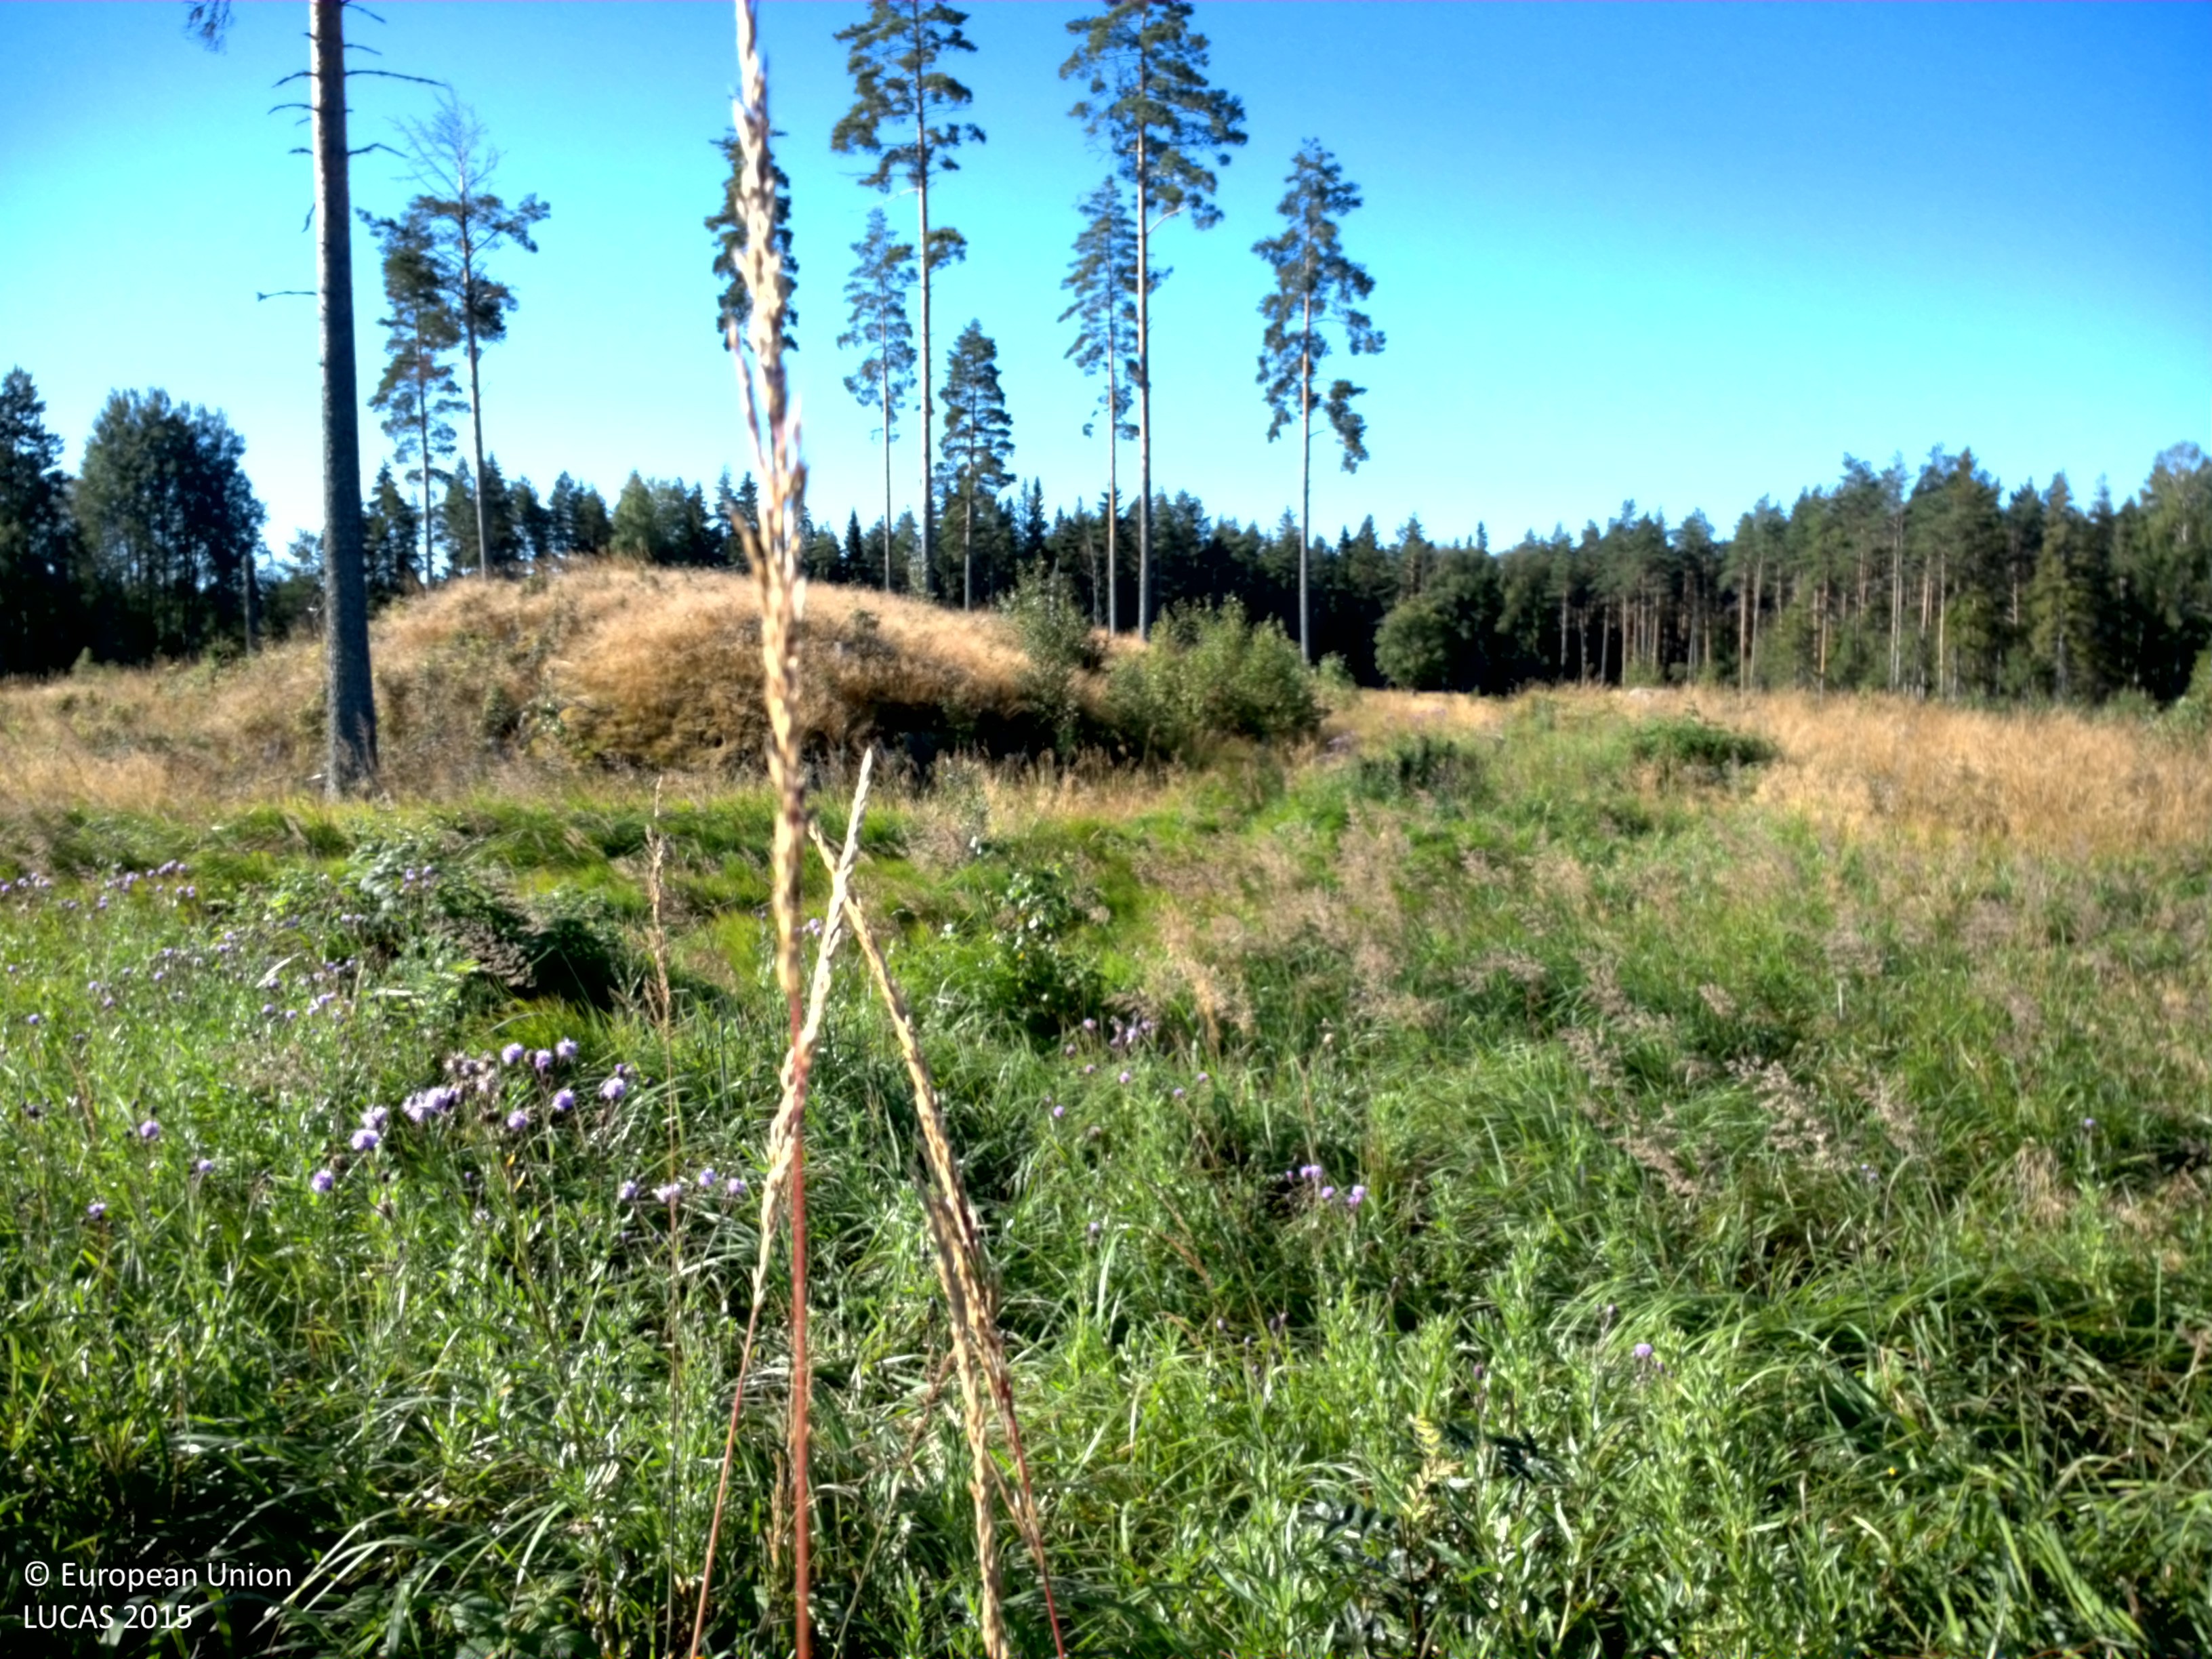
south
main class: Grassland
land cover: Grassland without tree/shrub cover
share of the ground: > 75 %
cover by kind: herbaceous plants 100 %
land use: Forestry
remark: Clear cut
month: August
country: SE
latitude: 60.1104
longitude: 17.0976
